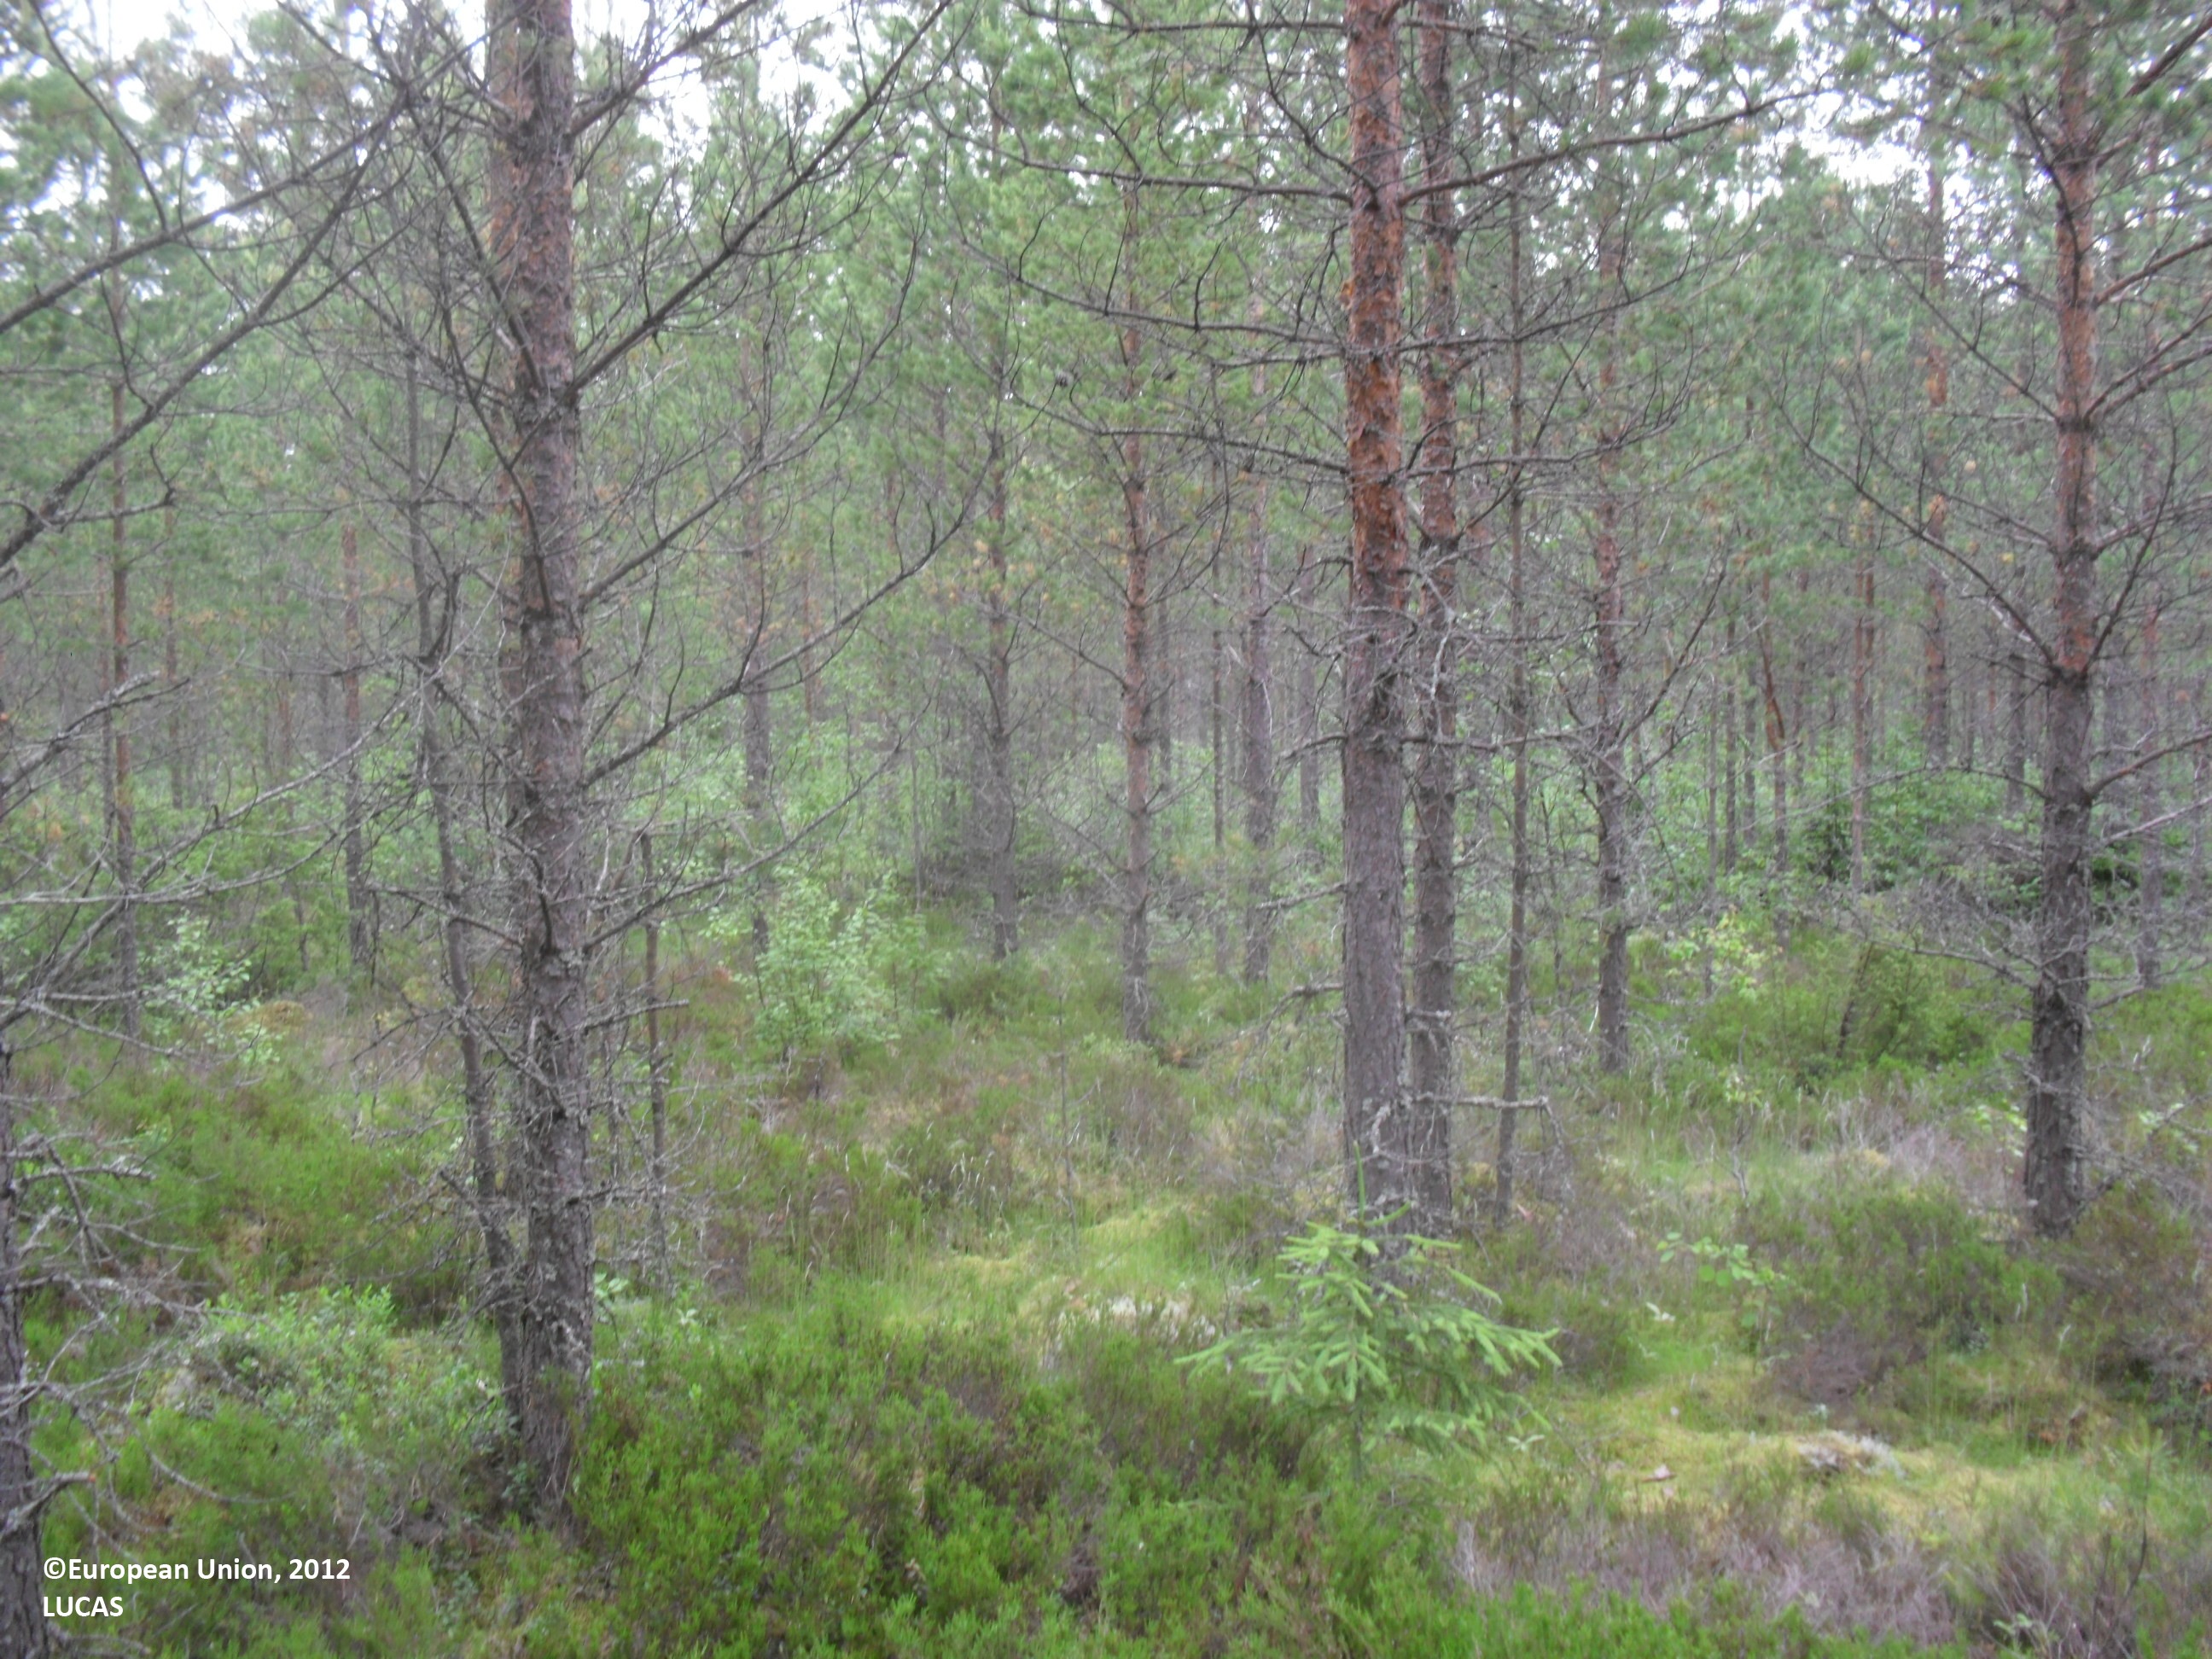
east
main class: Woodland
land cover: Pine dominated coniferous woodland
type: boreal forest
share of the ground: 50 - 75 %
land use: Forestry
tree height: > 5 m
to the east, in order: Pine dominated coniferous woodland; Pine dominated mixed woodland; Ditches and canals; Pine dominated mixed woodland; Tracks; Pine dominated mixed woodland; Ditches and canals; Pine dominated mixed woodland; Ditches and canals; Other mixed woodland; Ditches and canals; Other mixed woodland; Pine dominated mixed woodland
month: June
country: FI
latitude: 62.9099
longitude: 23.5913
